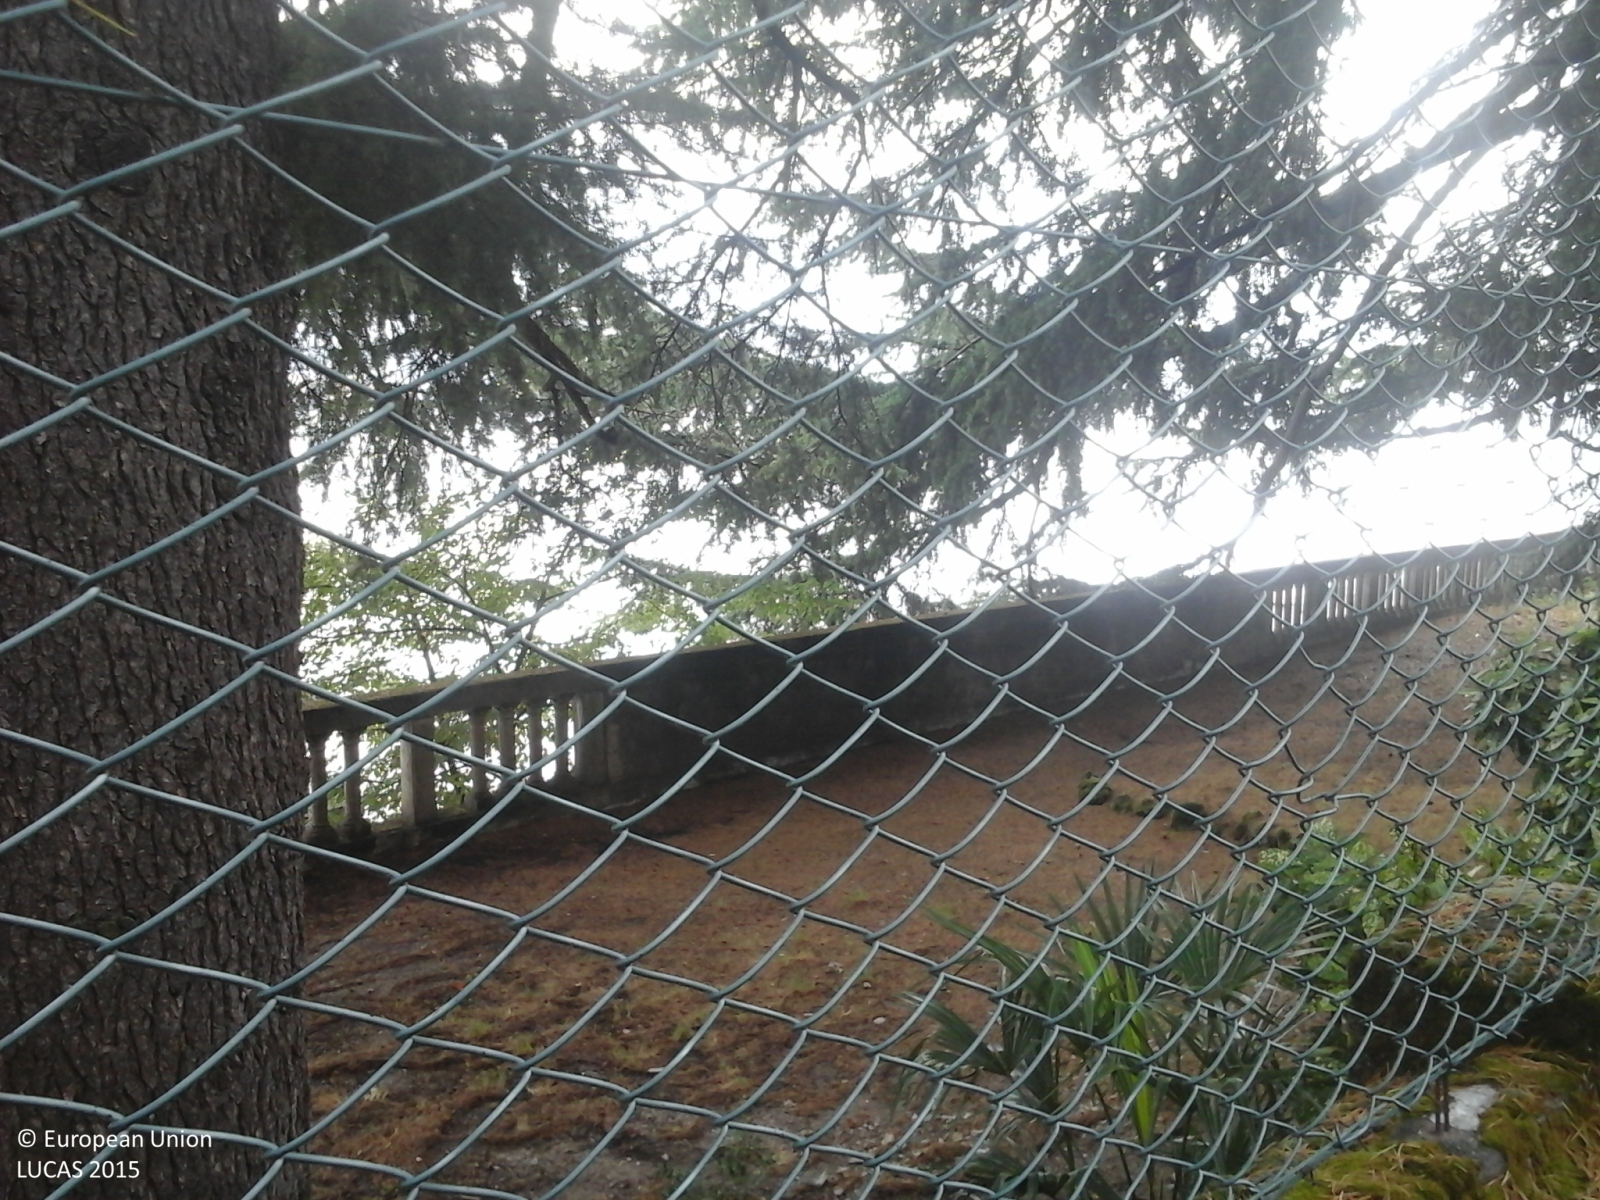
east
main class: Woodland
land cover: Other coniferous woodland
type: alpine coniferous forest
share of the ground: > 75 %
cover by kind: coniferous forest trees 100 %
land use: Residential
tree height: > 5 m
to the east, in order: Other coniferous woodland; Fences; Rocks and stones; Inland fresh water bodies
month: July
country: IT
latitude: 45.9165
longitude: 9.2920
